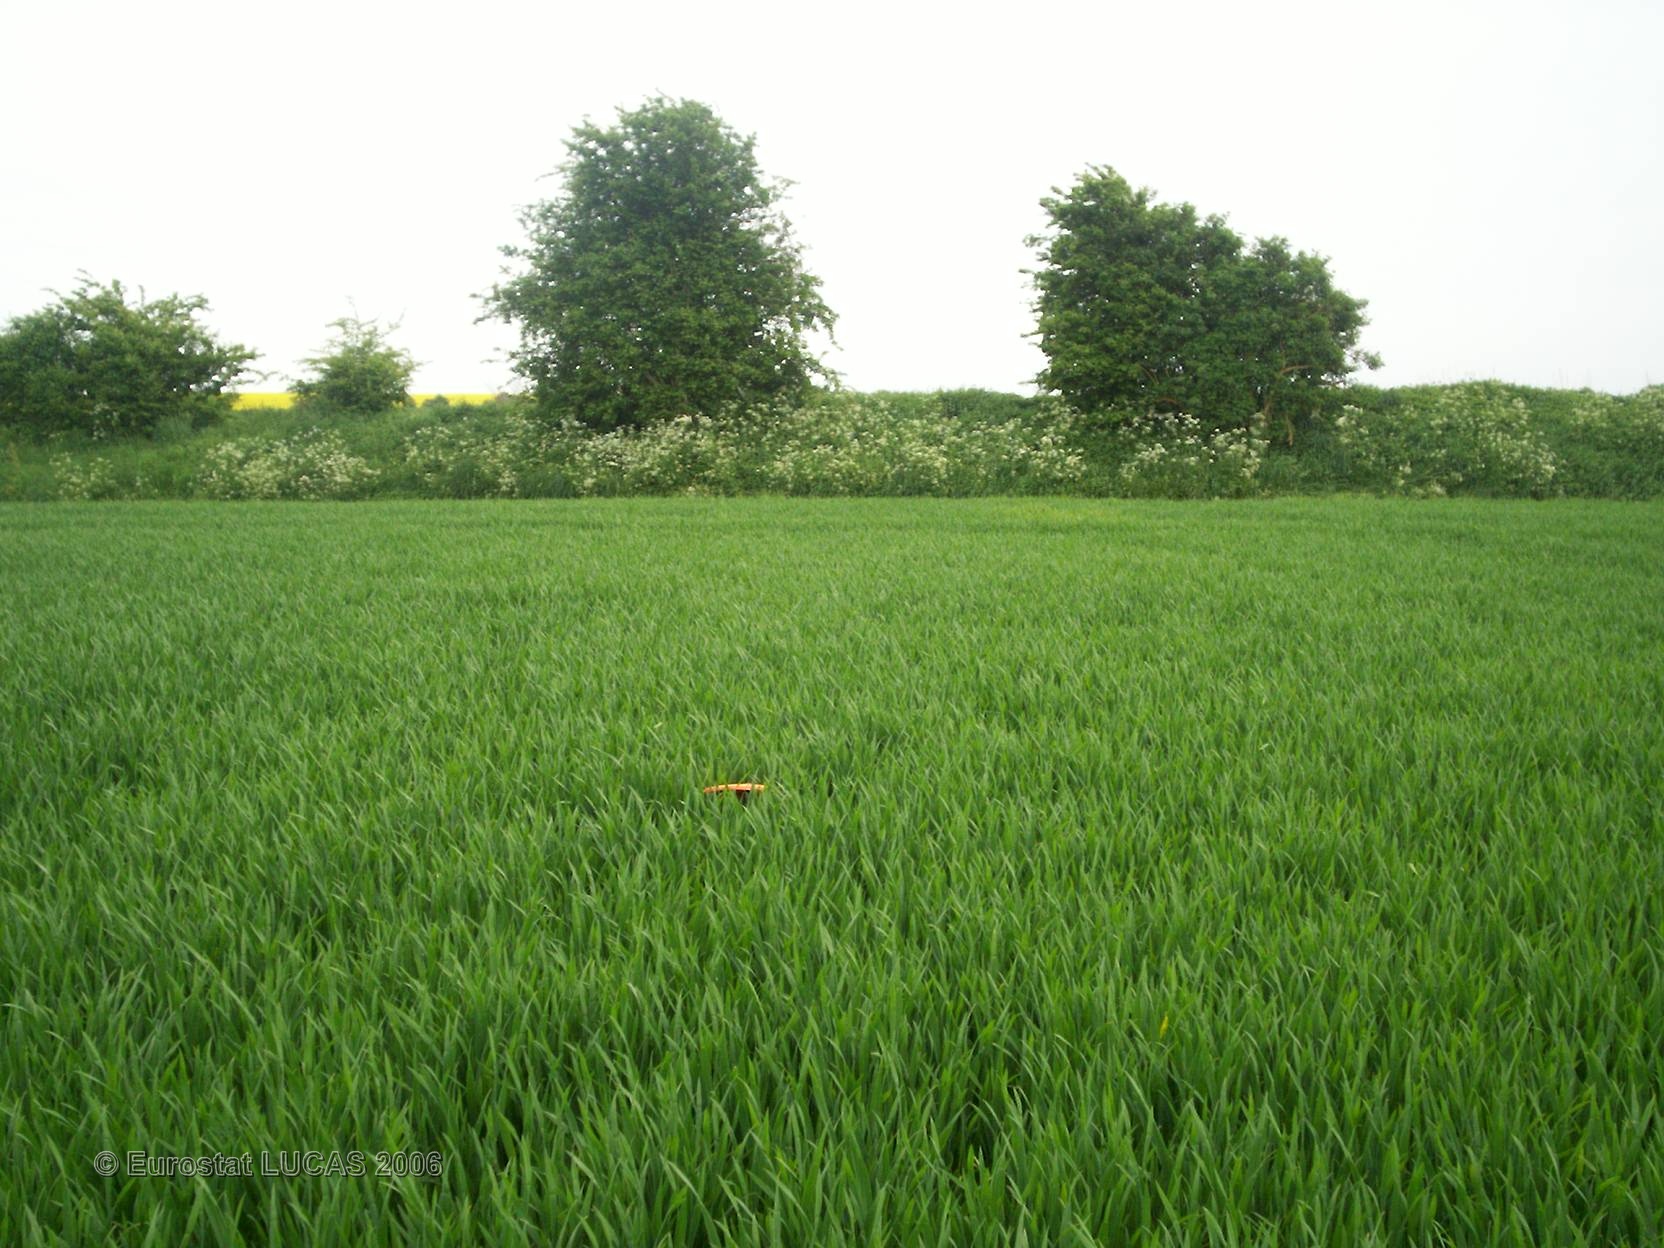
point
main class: Cropland
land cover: Common wheat
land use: Agriculture (excluding fallow land and kitchen gardens)
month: May
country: FR
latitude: 50.2719
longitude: 2.6502
